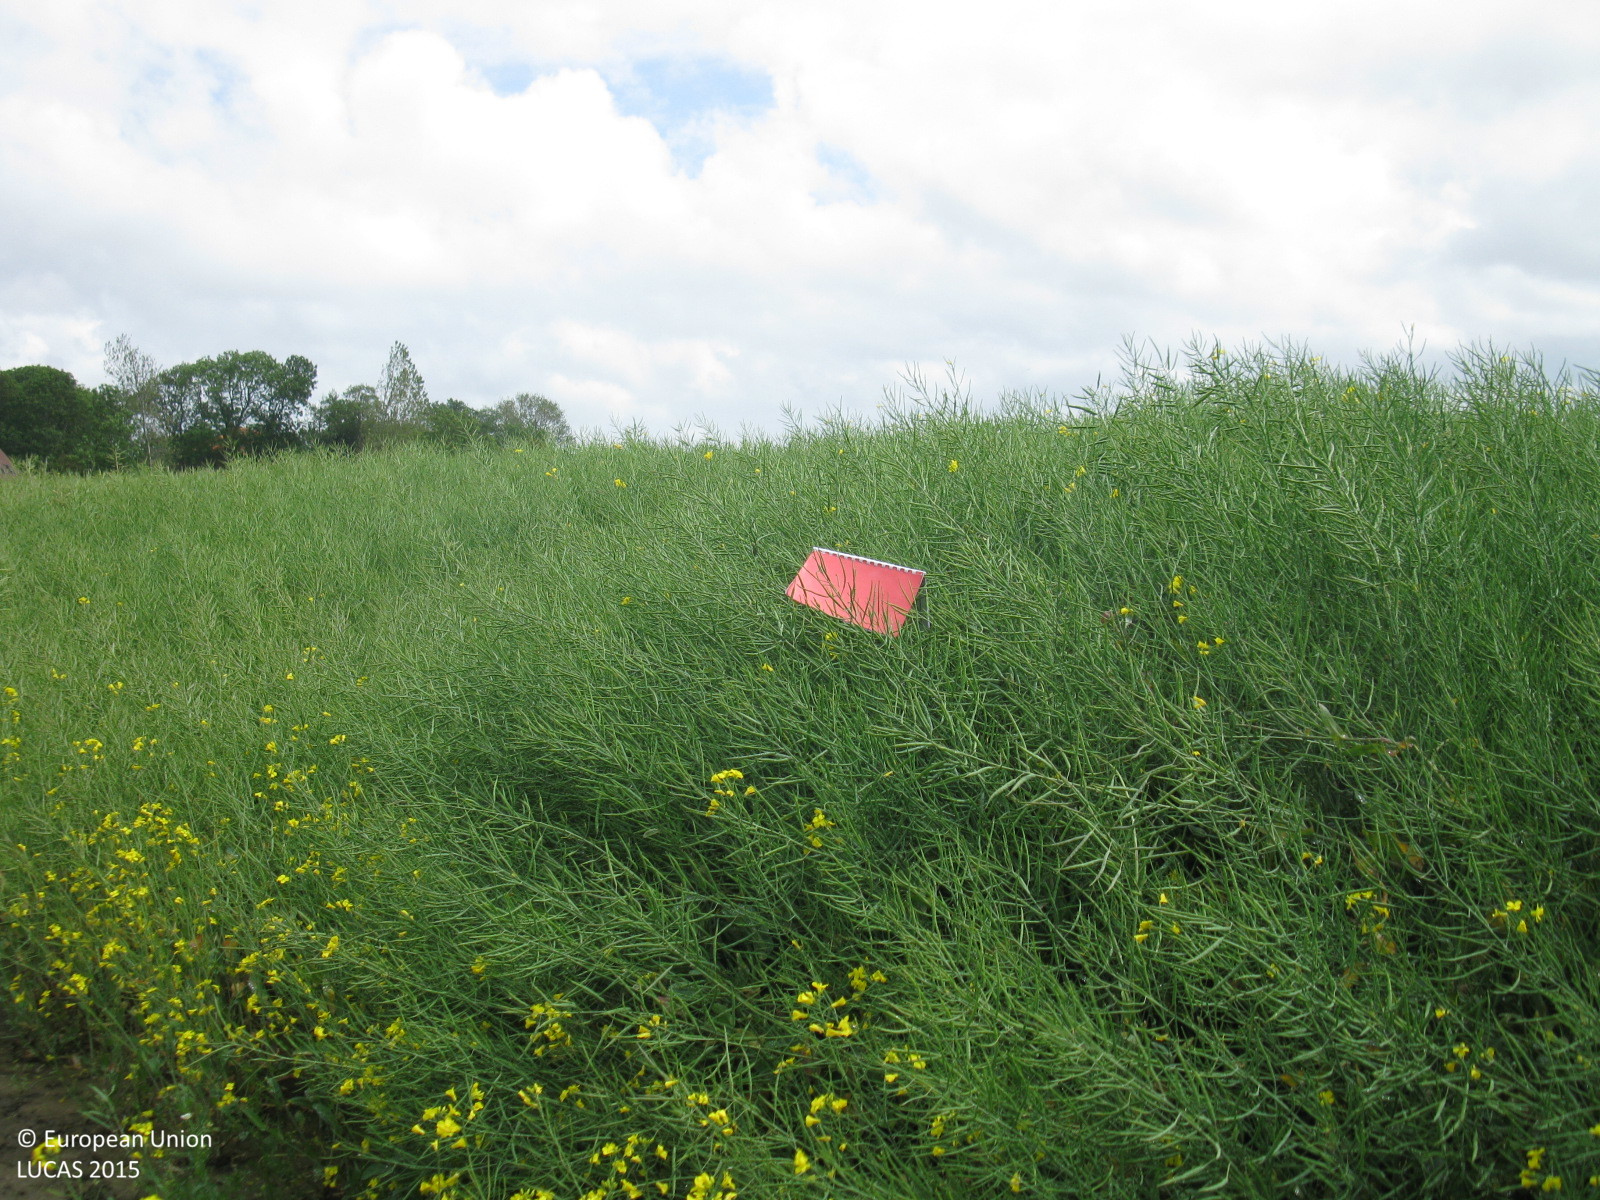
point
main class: Cropland
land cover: Rape and turnip rape
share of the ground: > 75 %
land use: Agriculture (excluding fallow land and kitchen gardens)
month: June
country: DE
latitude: 53.7088
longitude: 7.9858
